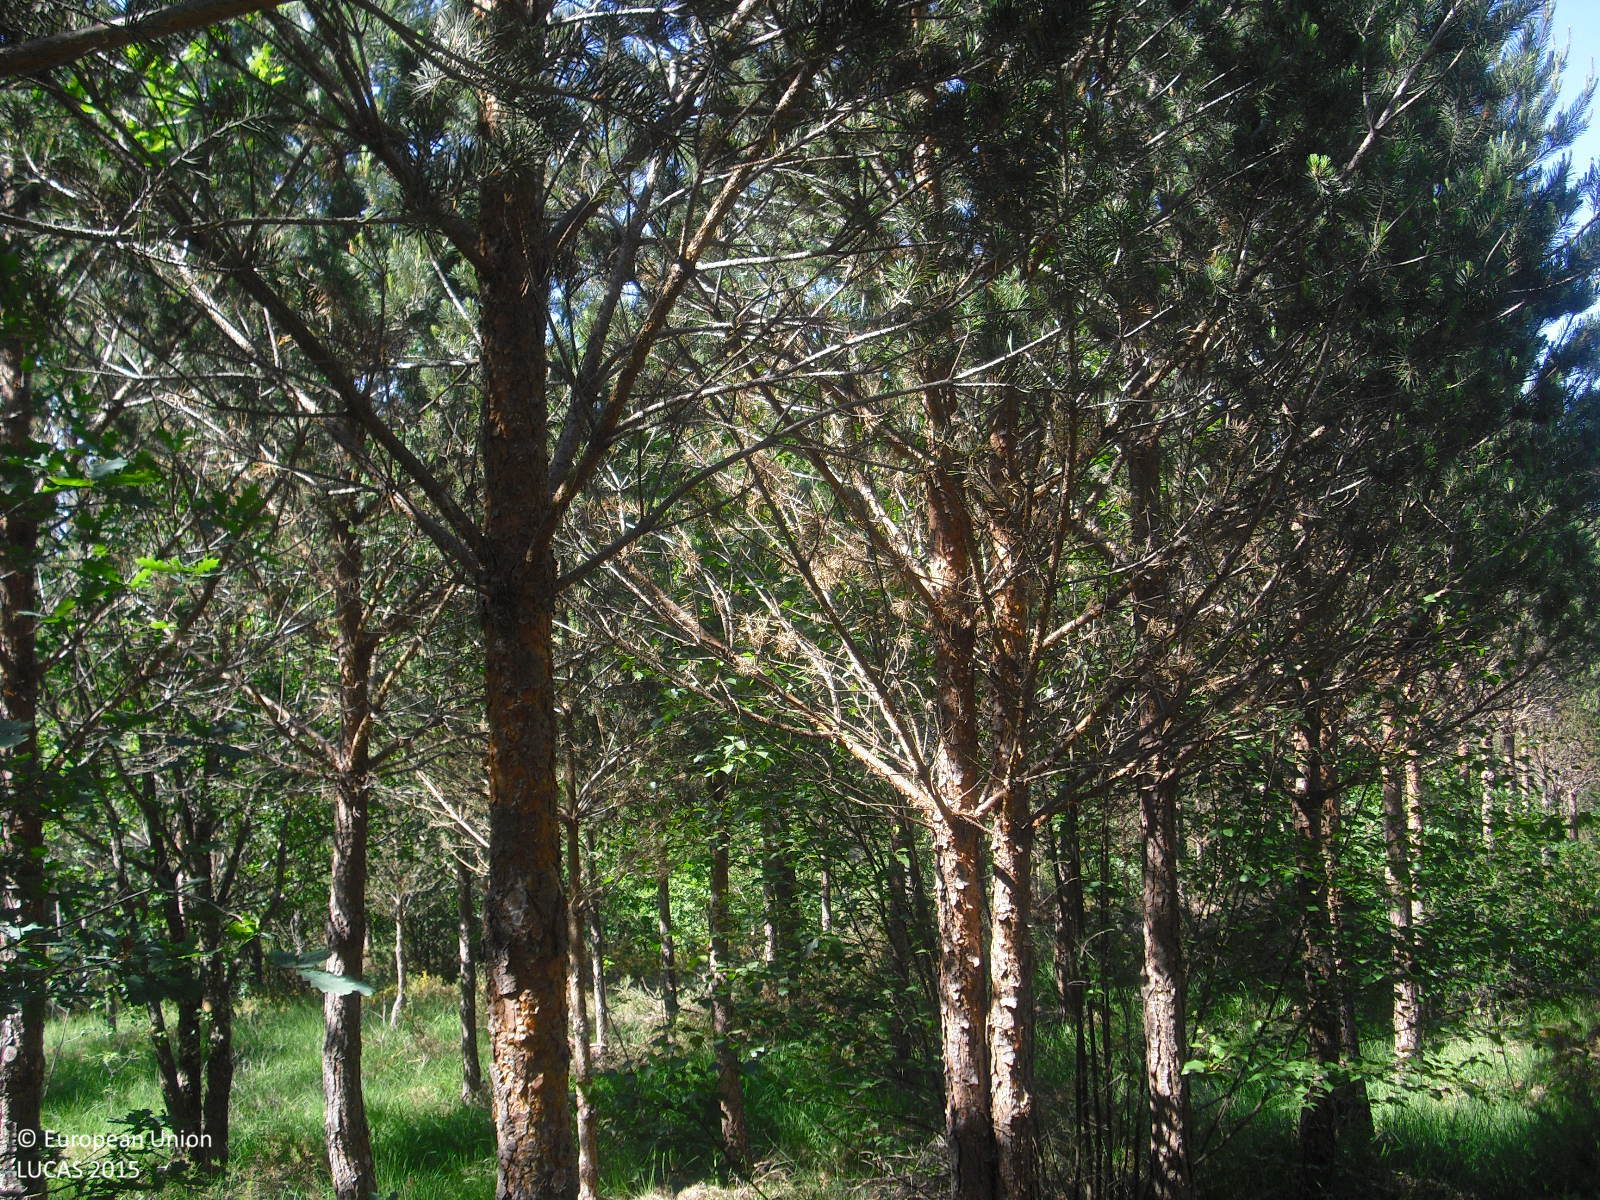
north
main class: Woodland
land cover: Pine dominated coniferous woodland
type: hemiboreal forest and nemoral coniferous forest and mixed broadleaved-coniferous forest
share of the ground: > 75 %
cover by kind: coniferous forest trees 80 %, shrubs 15 %, broadleaved forest trees 5 %
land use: Forestry
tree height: > 5 m
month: May
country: ES
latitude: 42.2368
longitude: -7.6279
